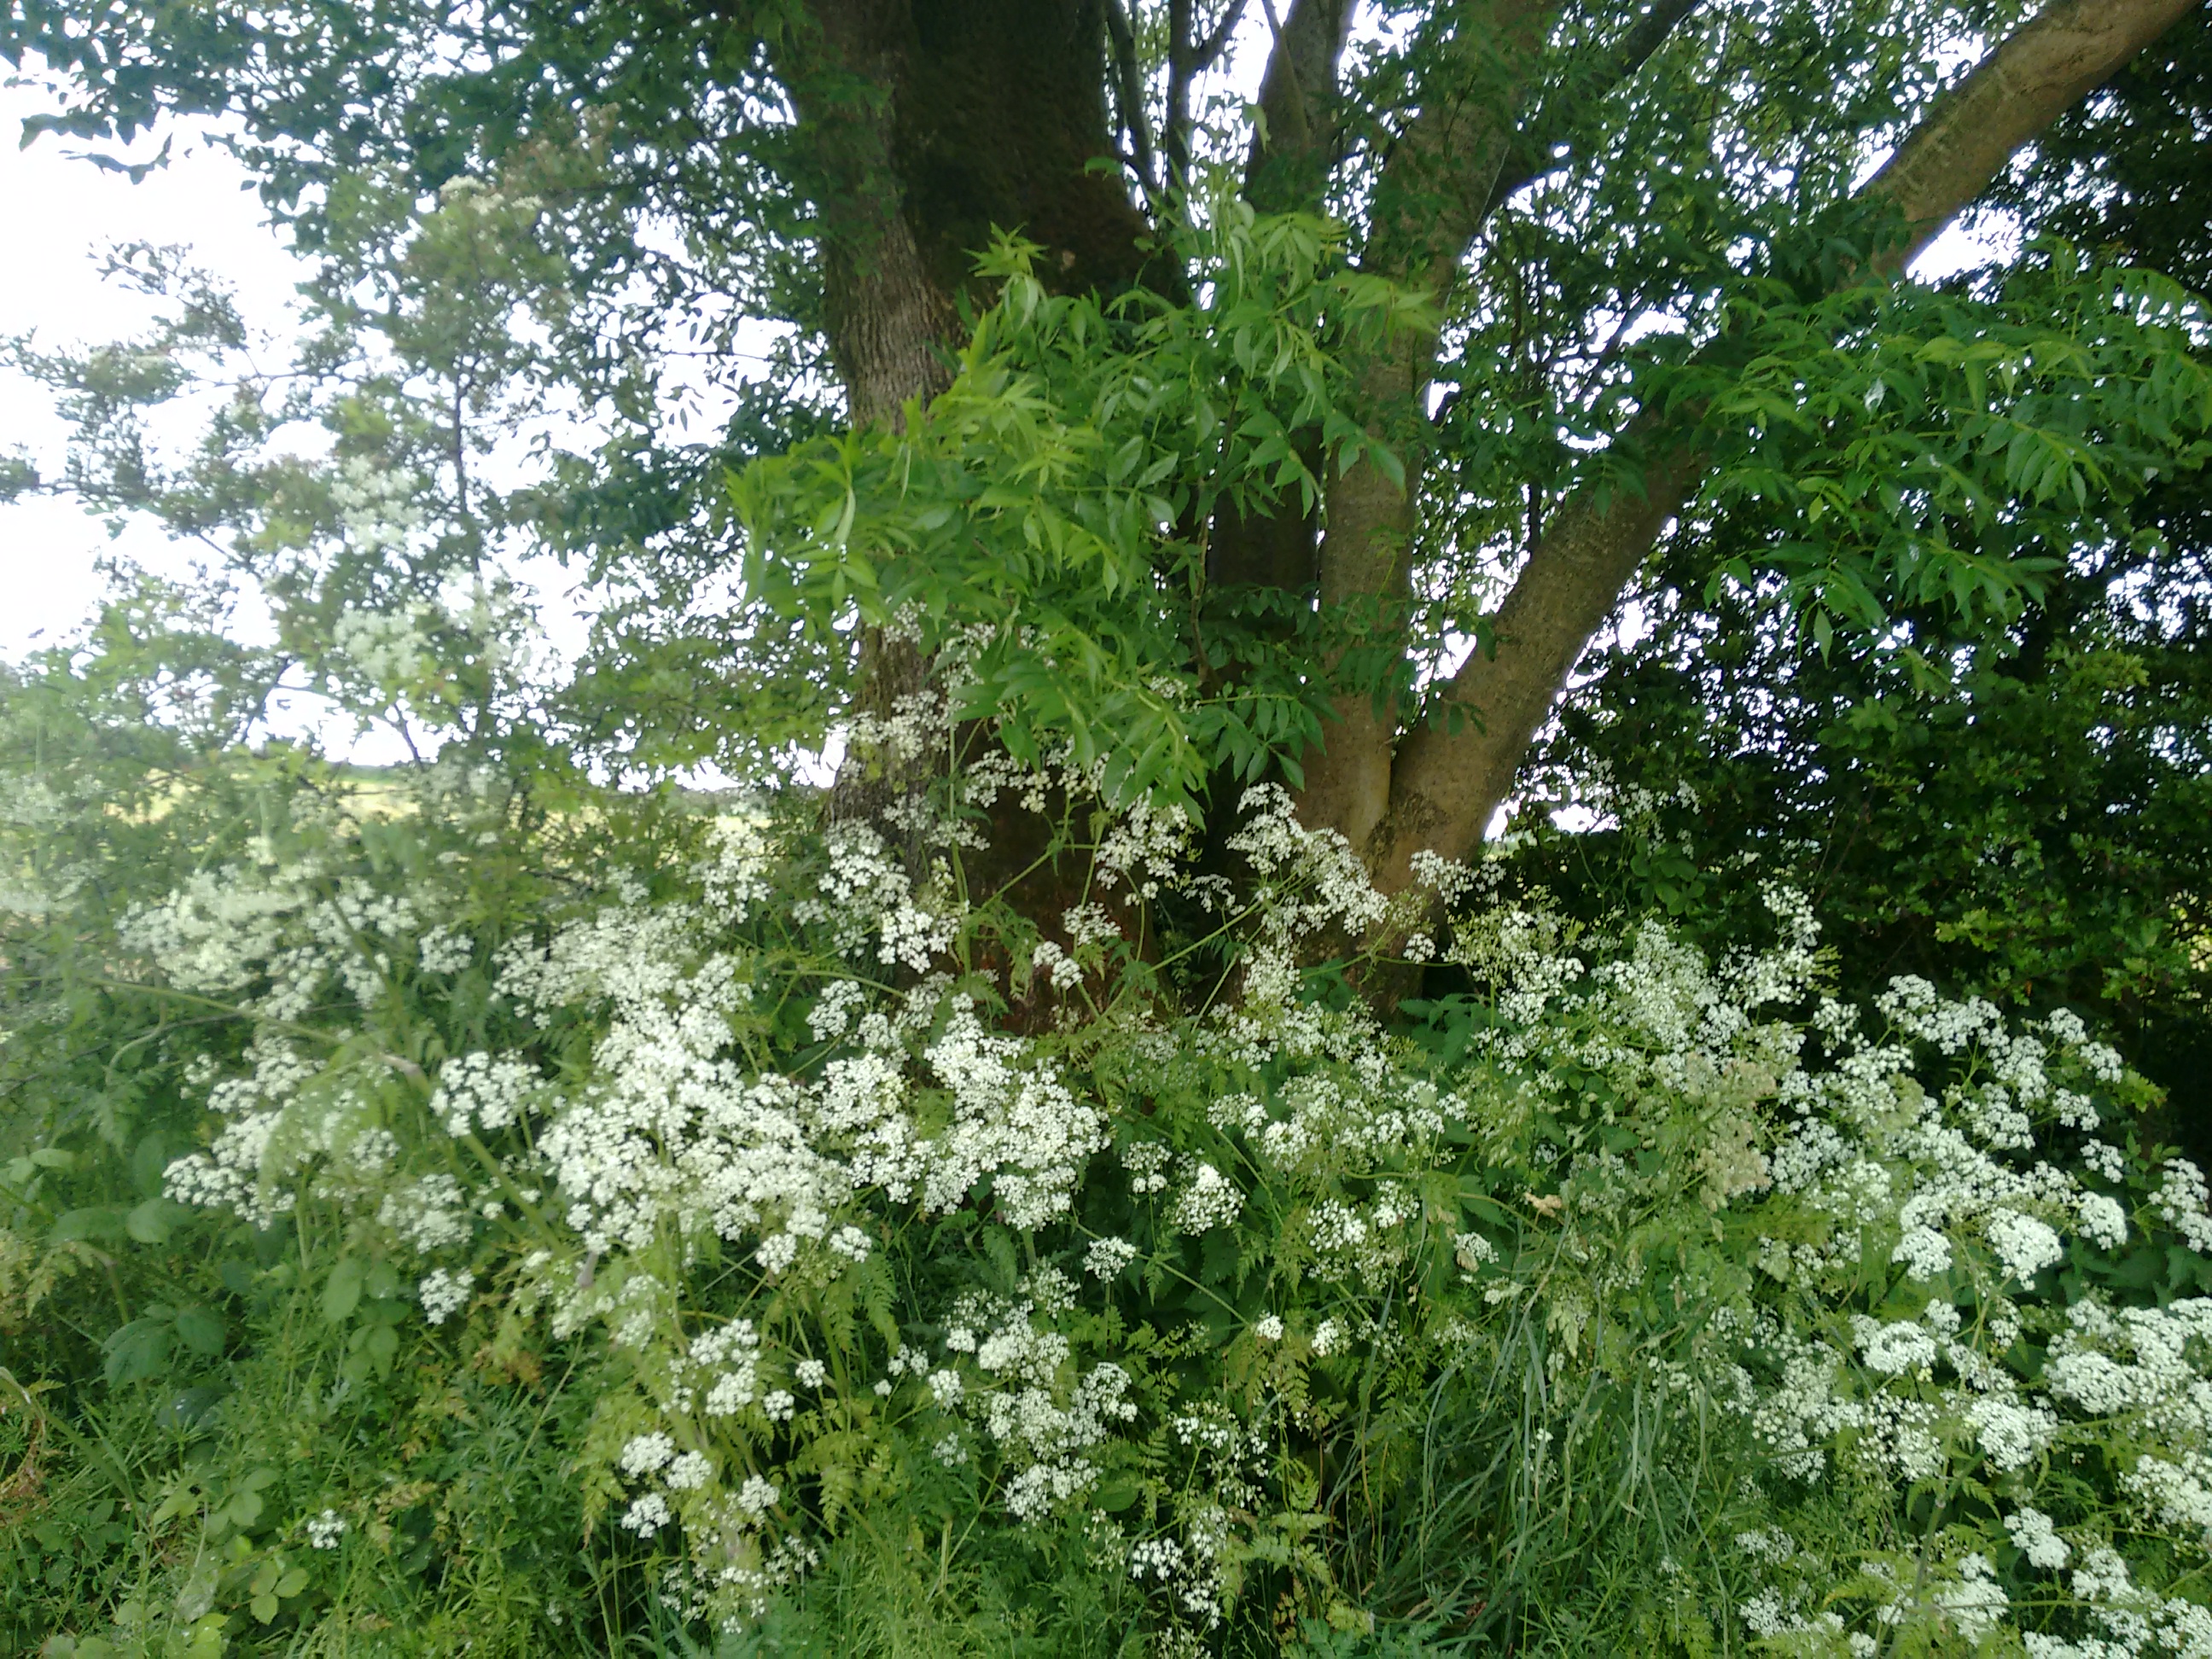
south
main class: Grassland
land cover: Grassland without tree/shrub cover
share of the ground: > 75 %
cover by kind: herbaceous plants 100 %
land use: Agriculture (excluding fallow land and kitchen gardens)
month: June
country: GB
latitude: 54.6913
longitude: -7.5159
